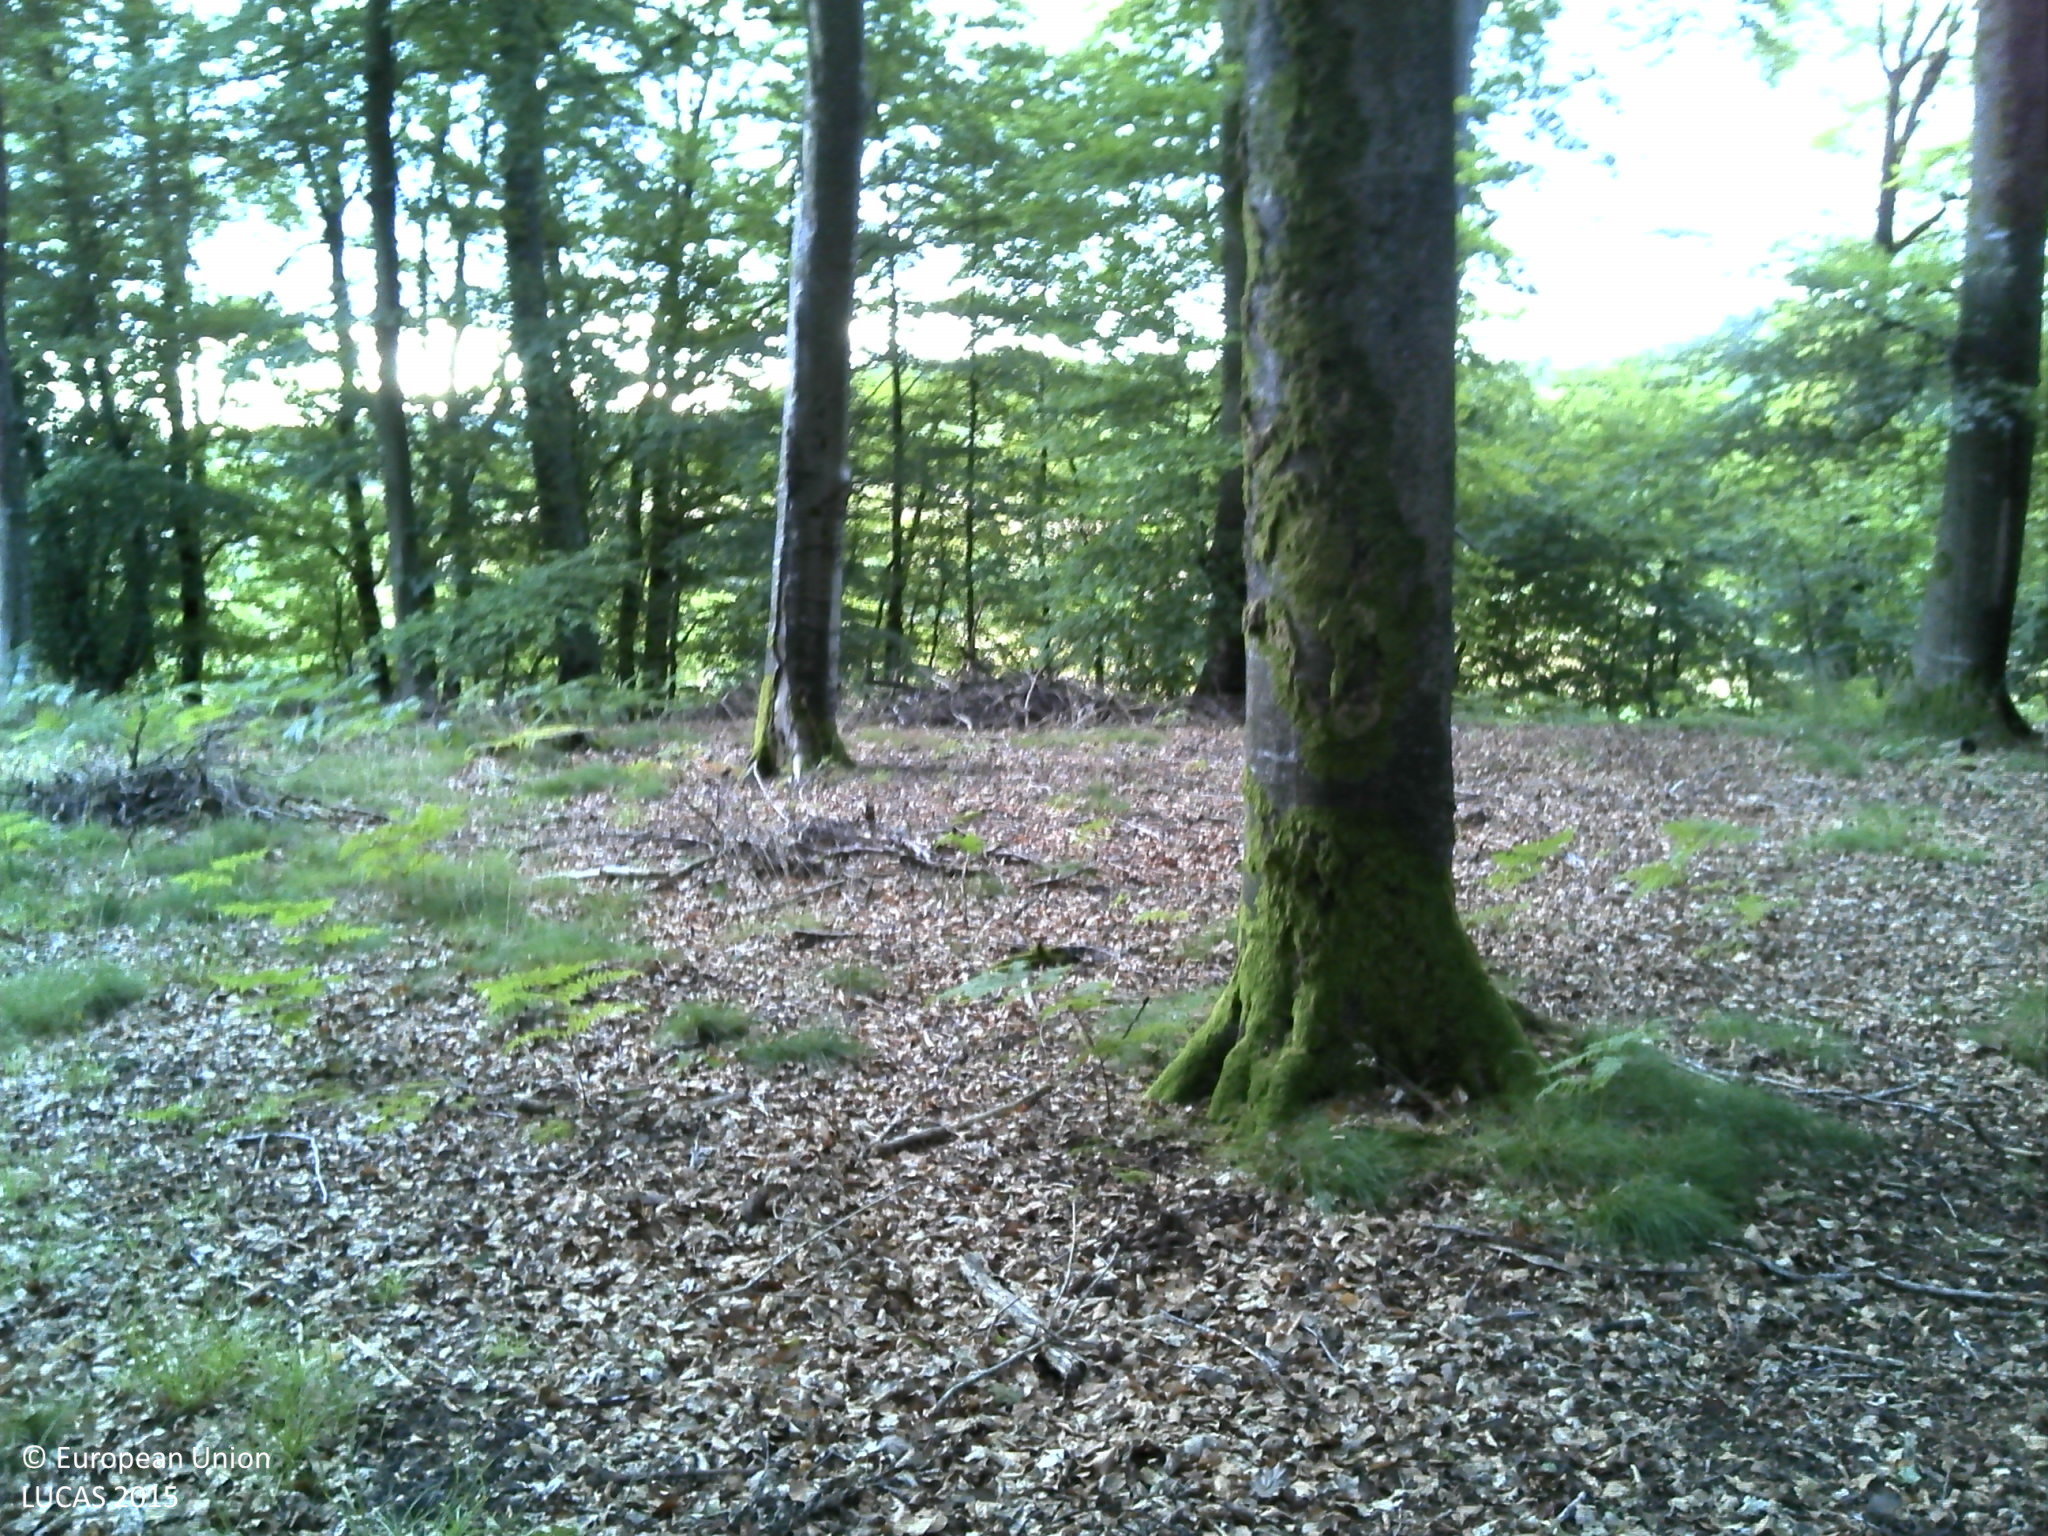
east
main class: Woodland
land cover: Broadleaved woodland
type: beech forest
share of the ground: > 75 %
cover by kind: broadleaved forest trees 80 %, unconsolidated bare surface 20 %
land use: Forestry
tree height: > 5 m
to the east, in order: Broadleaved woodland; Clovers; Tracks; Spontaneously vegetated surfaces; Grassland with sparse tree/shrub cover
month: July
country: FR
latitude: 48.2505
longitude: 6.2699
